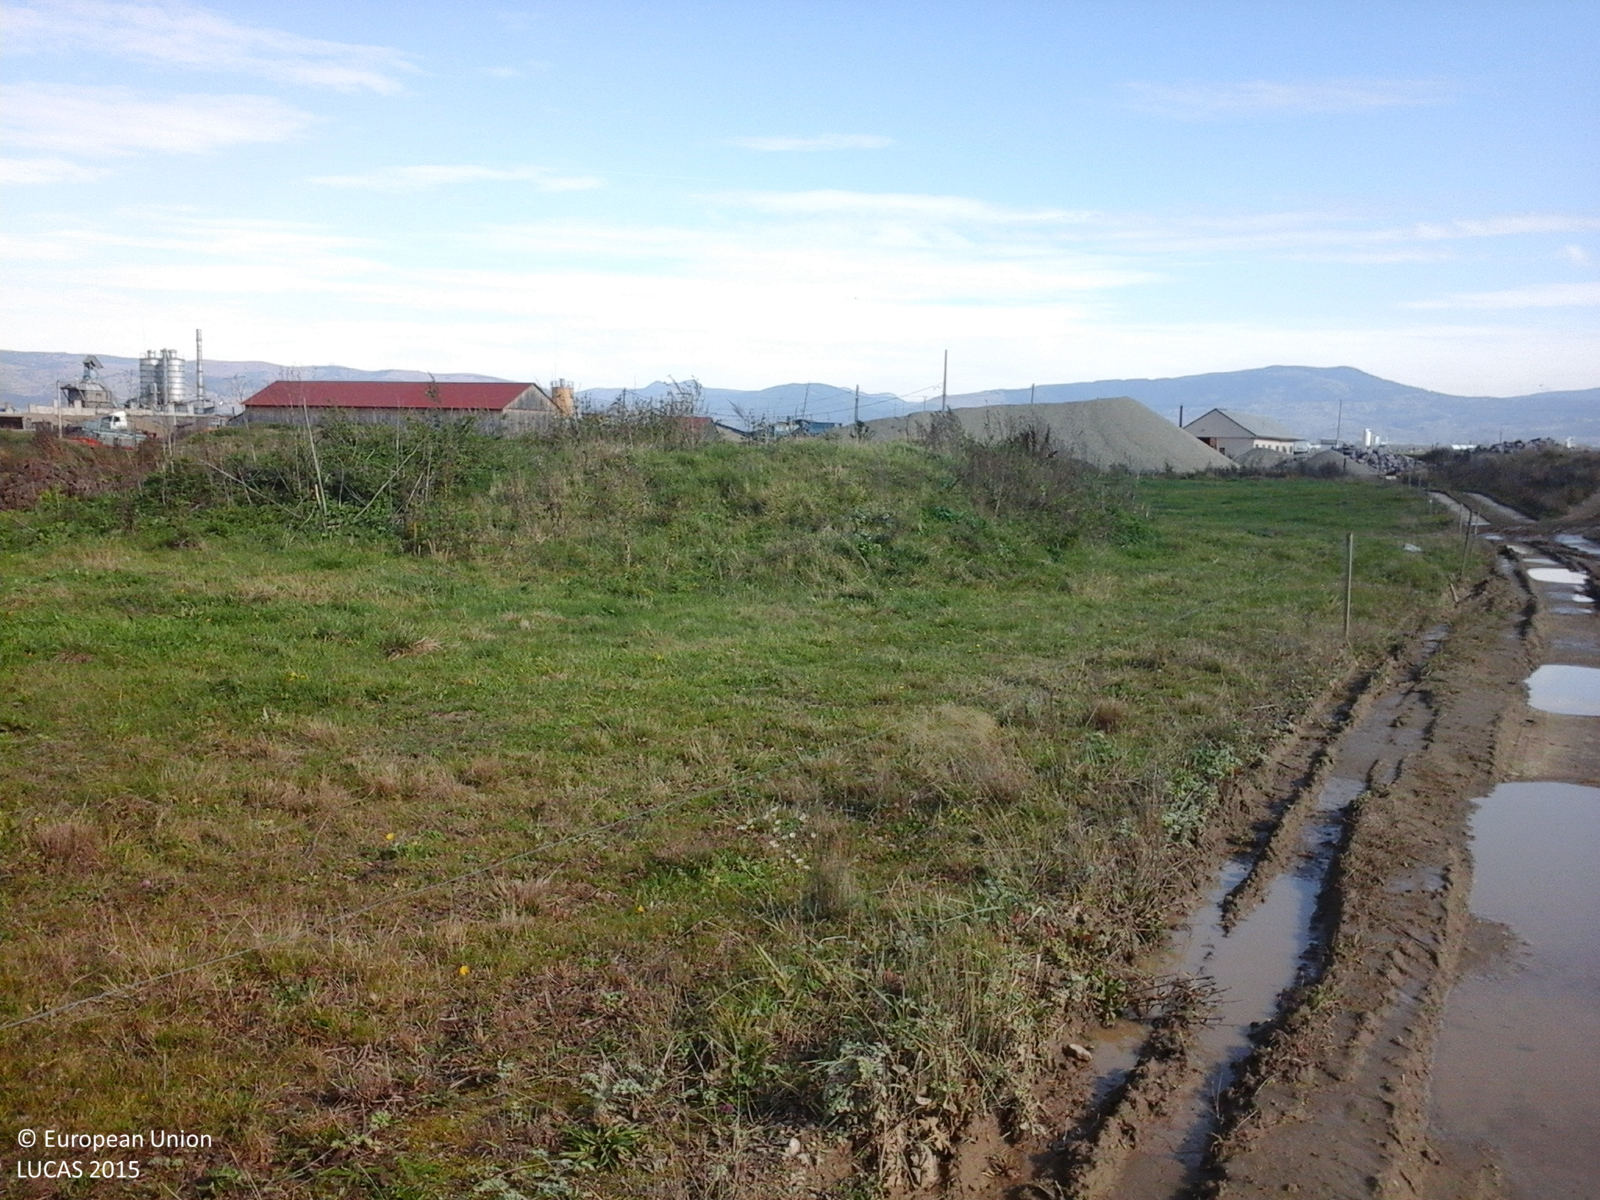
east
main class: Grassland
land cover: Grassland without tree/shrub cover
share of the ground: > 75 %
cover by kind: herbaceous plants 100 %
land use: Agriculture (excluding fallow land and kitchen gardens)
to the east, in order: Grassland without tree/shrub cover; Artificial constructions in urban areas
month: October
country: RO
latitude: 46.7143
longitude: 25.5078
